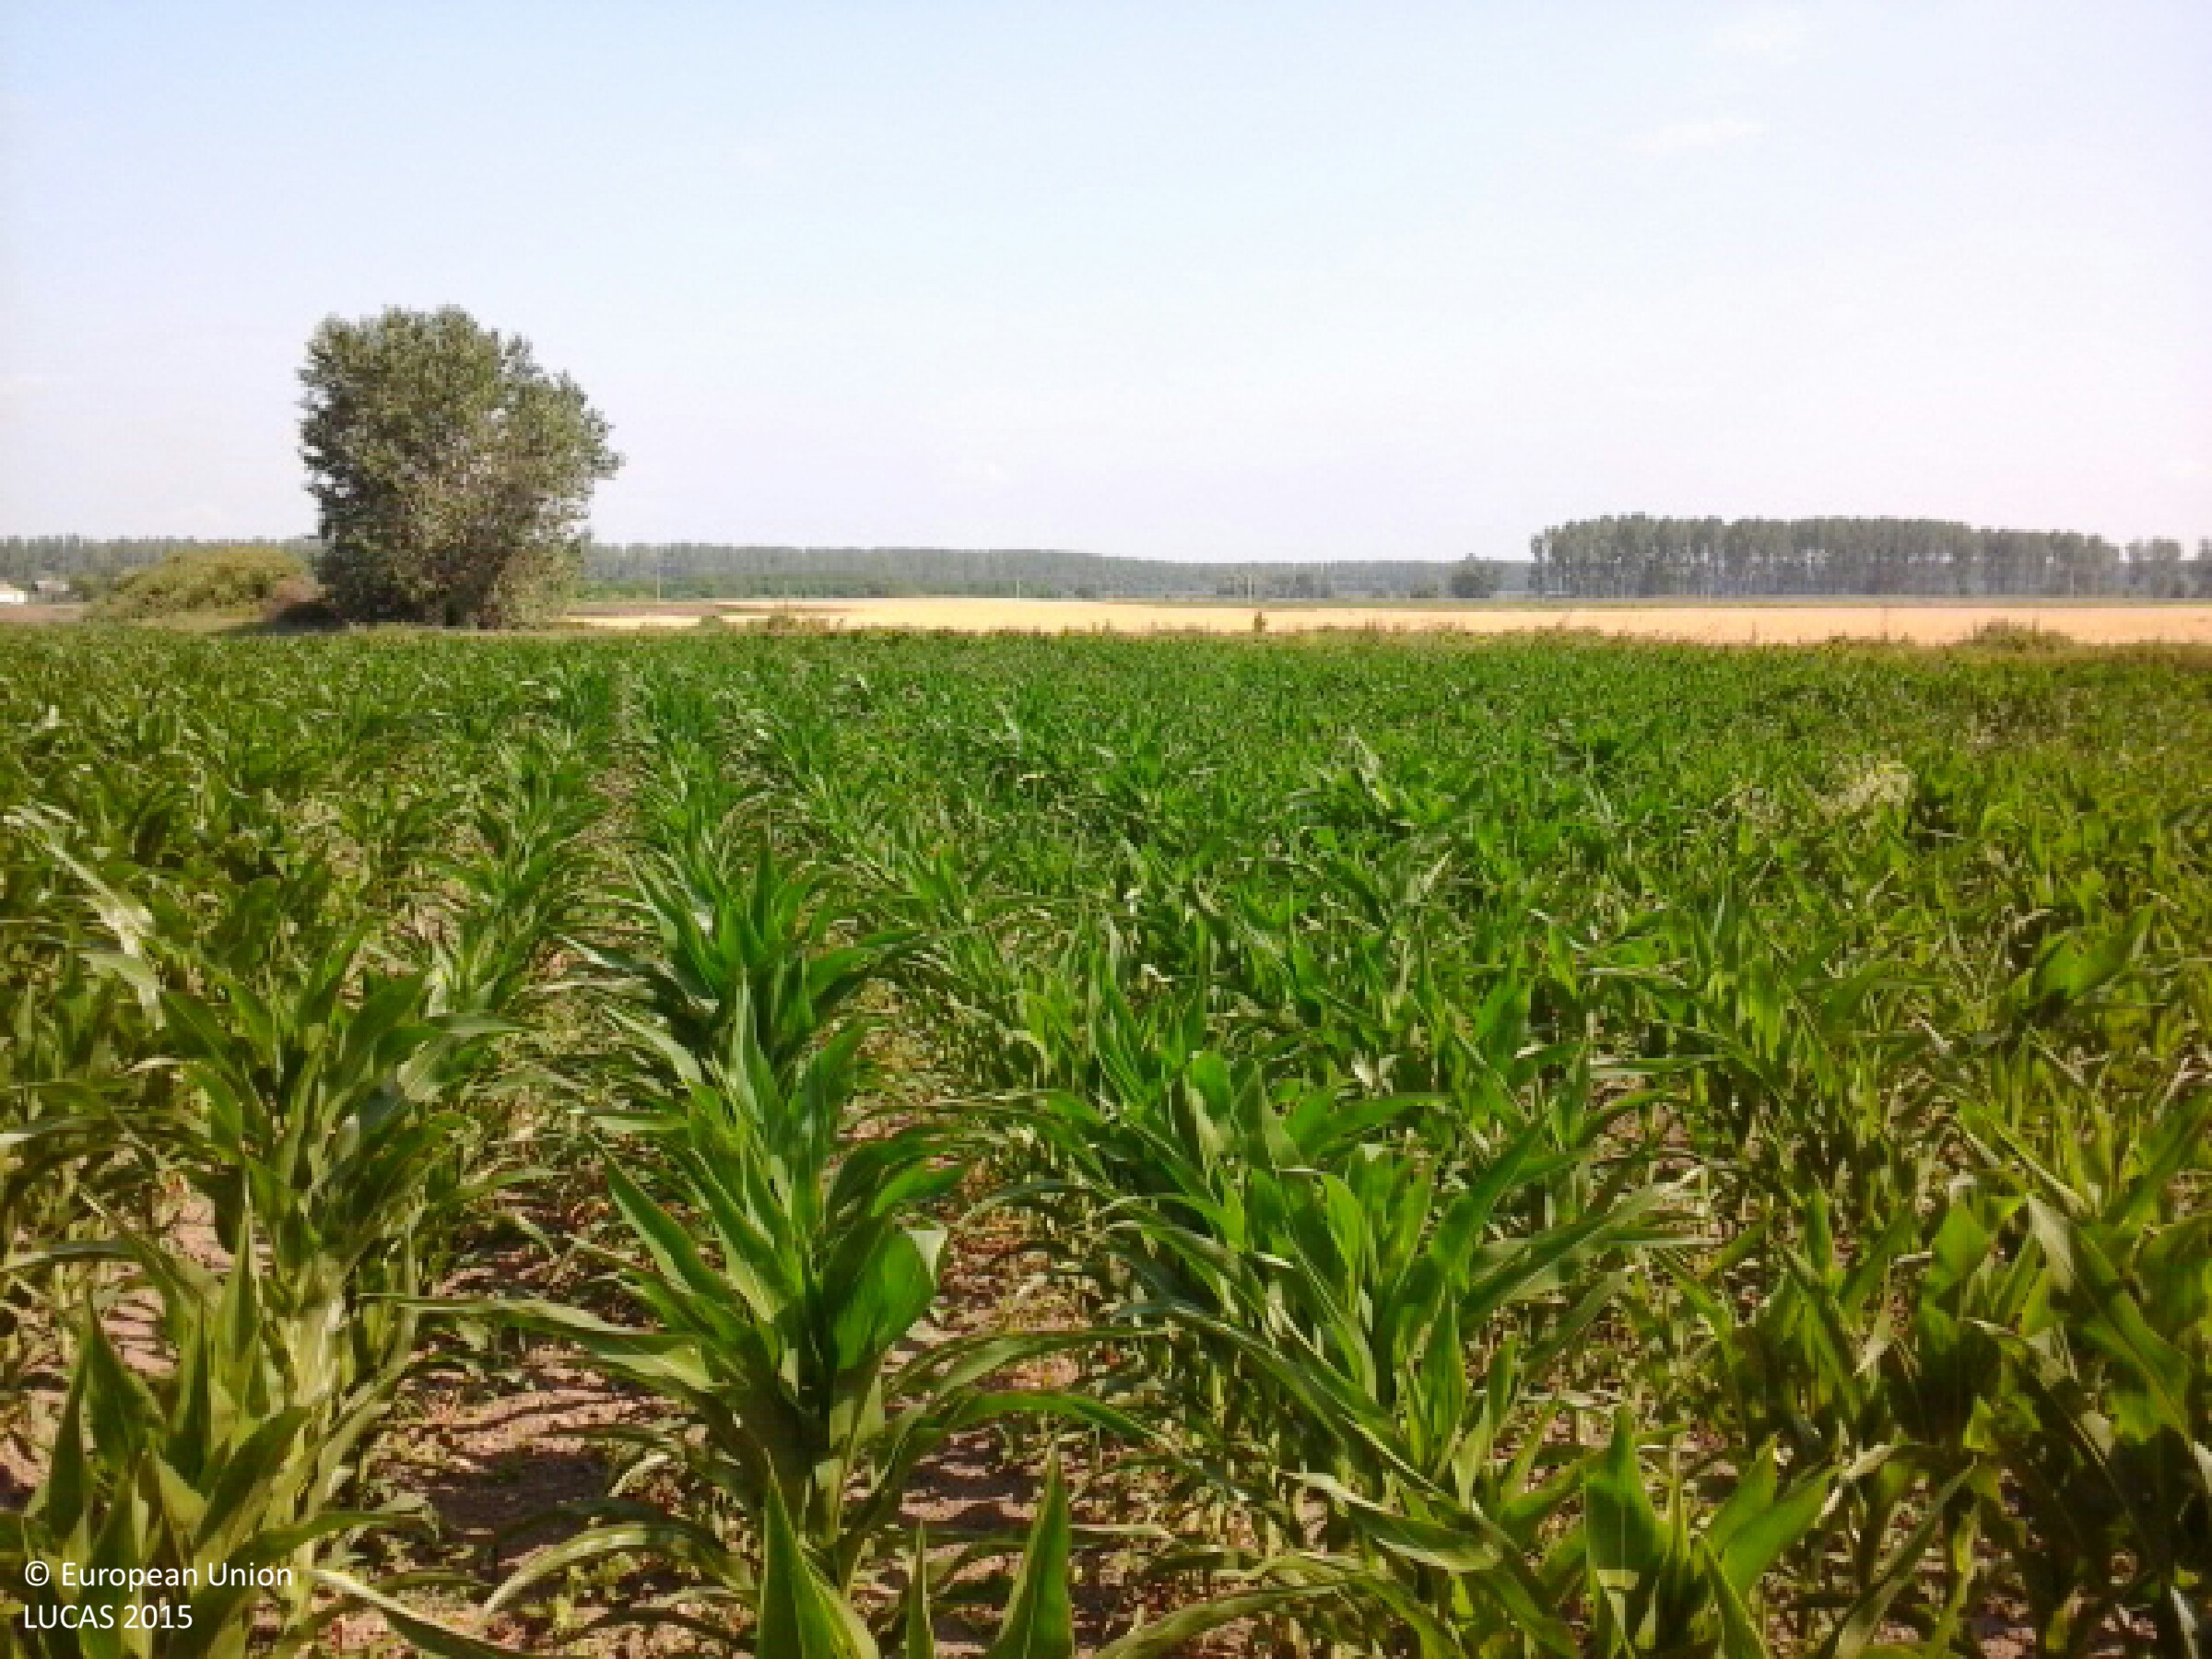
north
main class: Cropland
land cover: Maize
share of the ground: 50 - 75 %
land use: Agriculture (excluding fallow land and kitchen gardens)
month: June
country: HU
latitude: 48.2178
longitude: 21.8546
